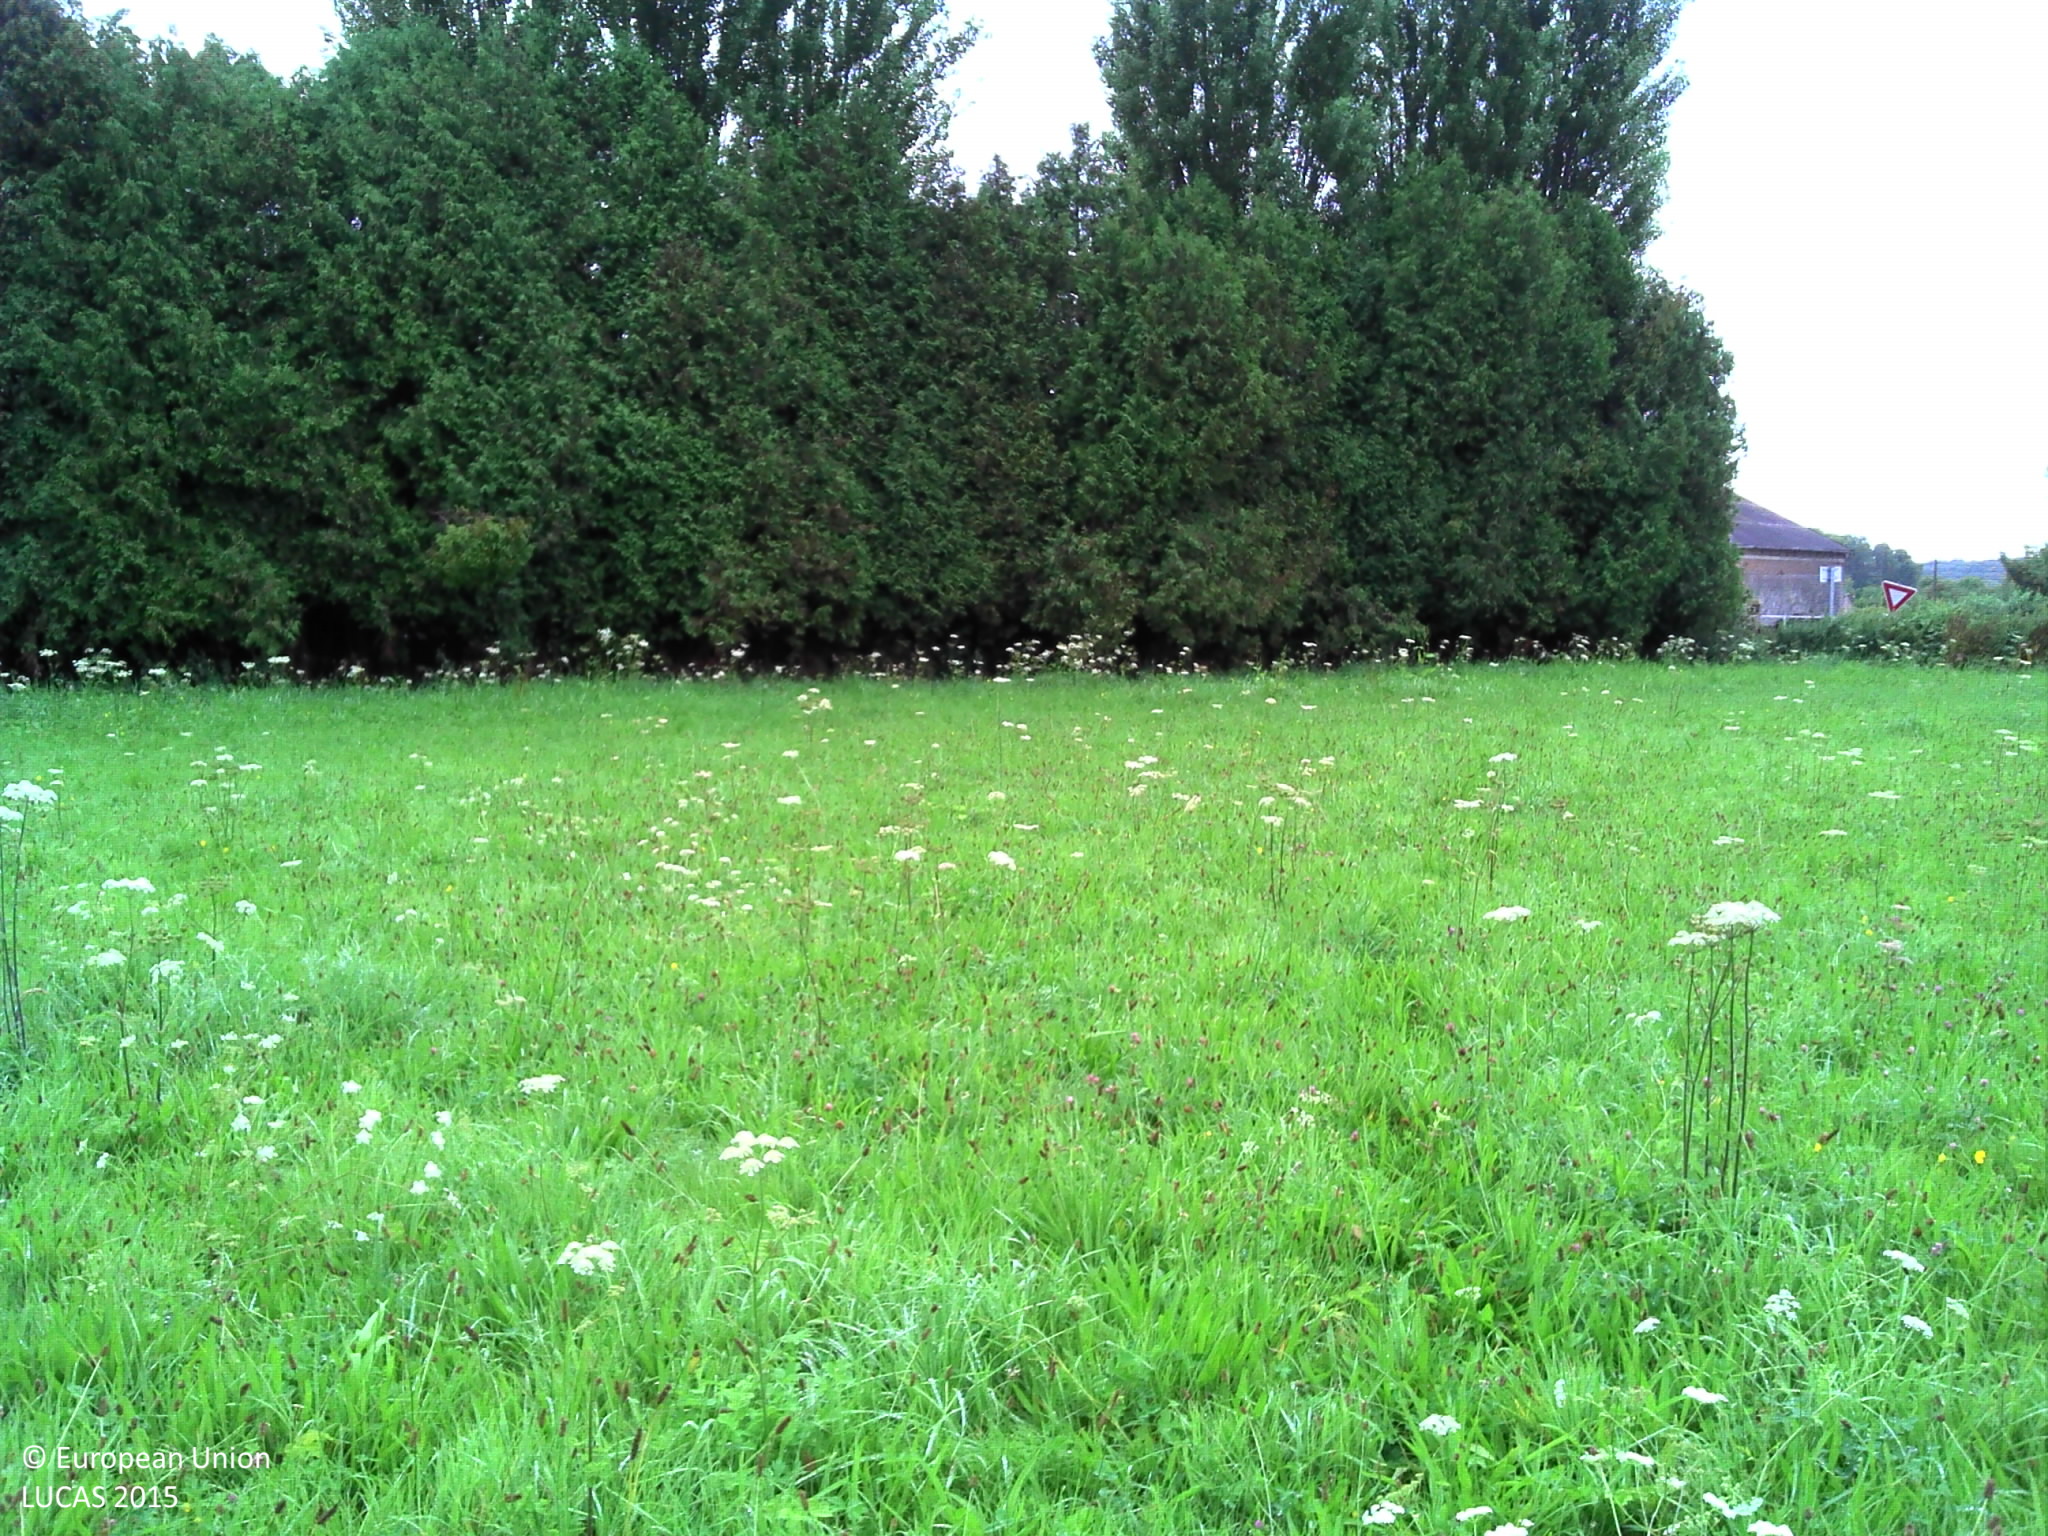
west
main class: Grassland
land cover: Grassland without tree/shrub cover
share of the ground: > 75 %
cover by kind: herbaceous plants 100 %
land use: Agriculture (excluding fallow land and kitchen gardens)
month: August
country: FR
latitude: 50.2653
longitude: 4.0885
